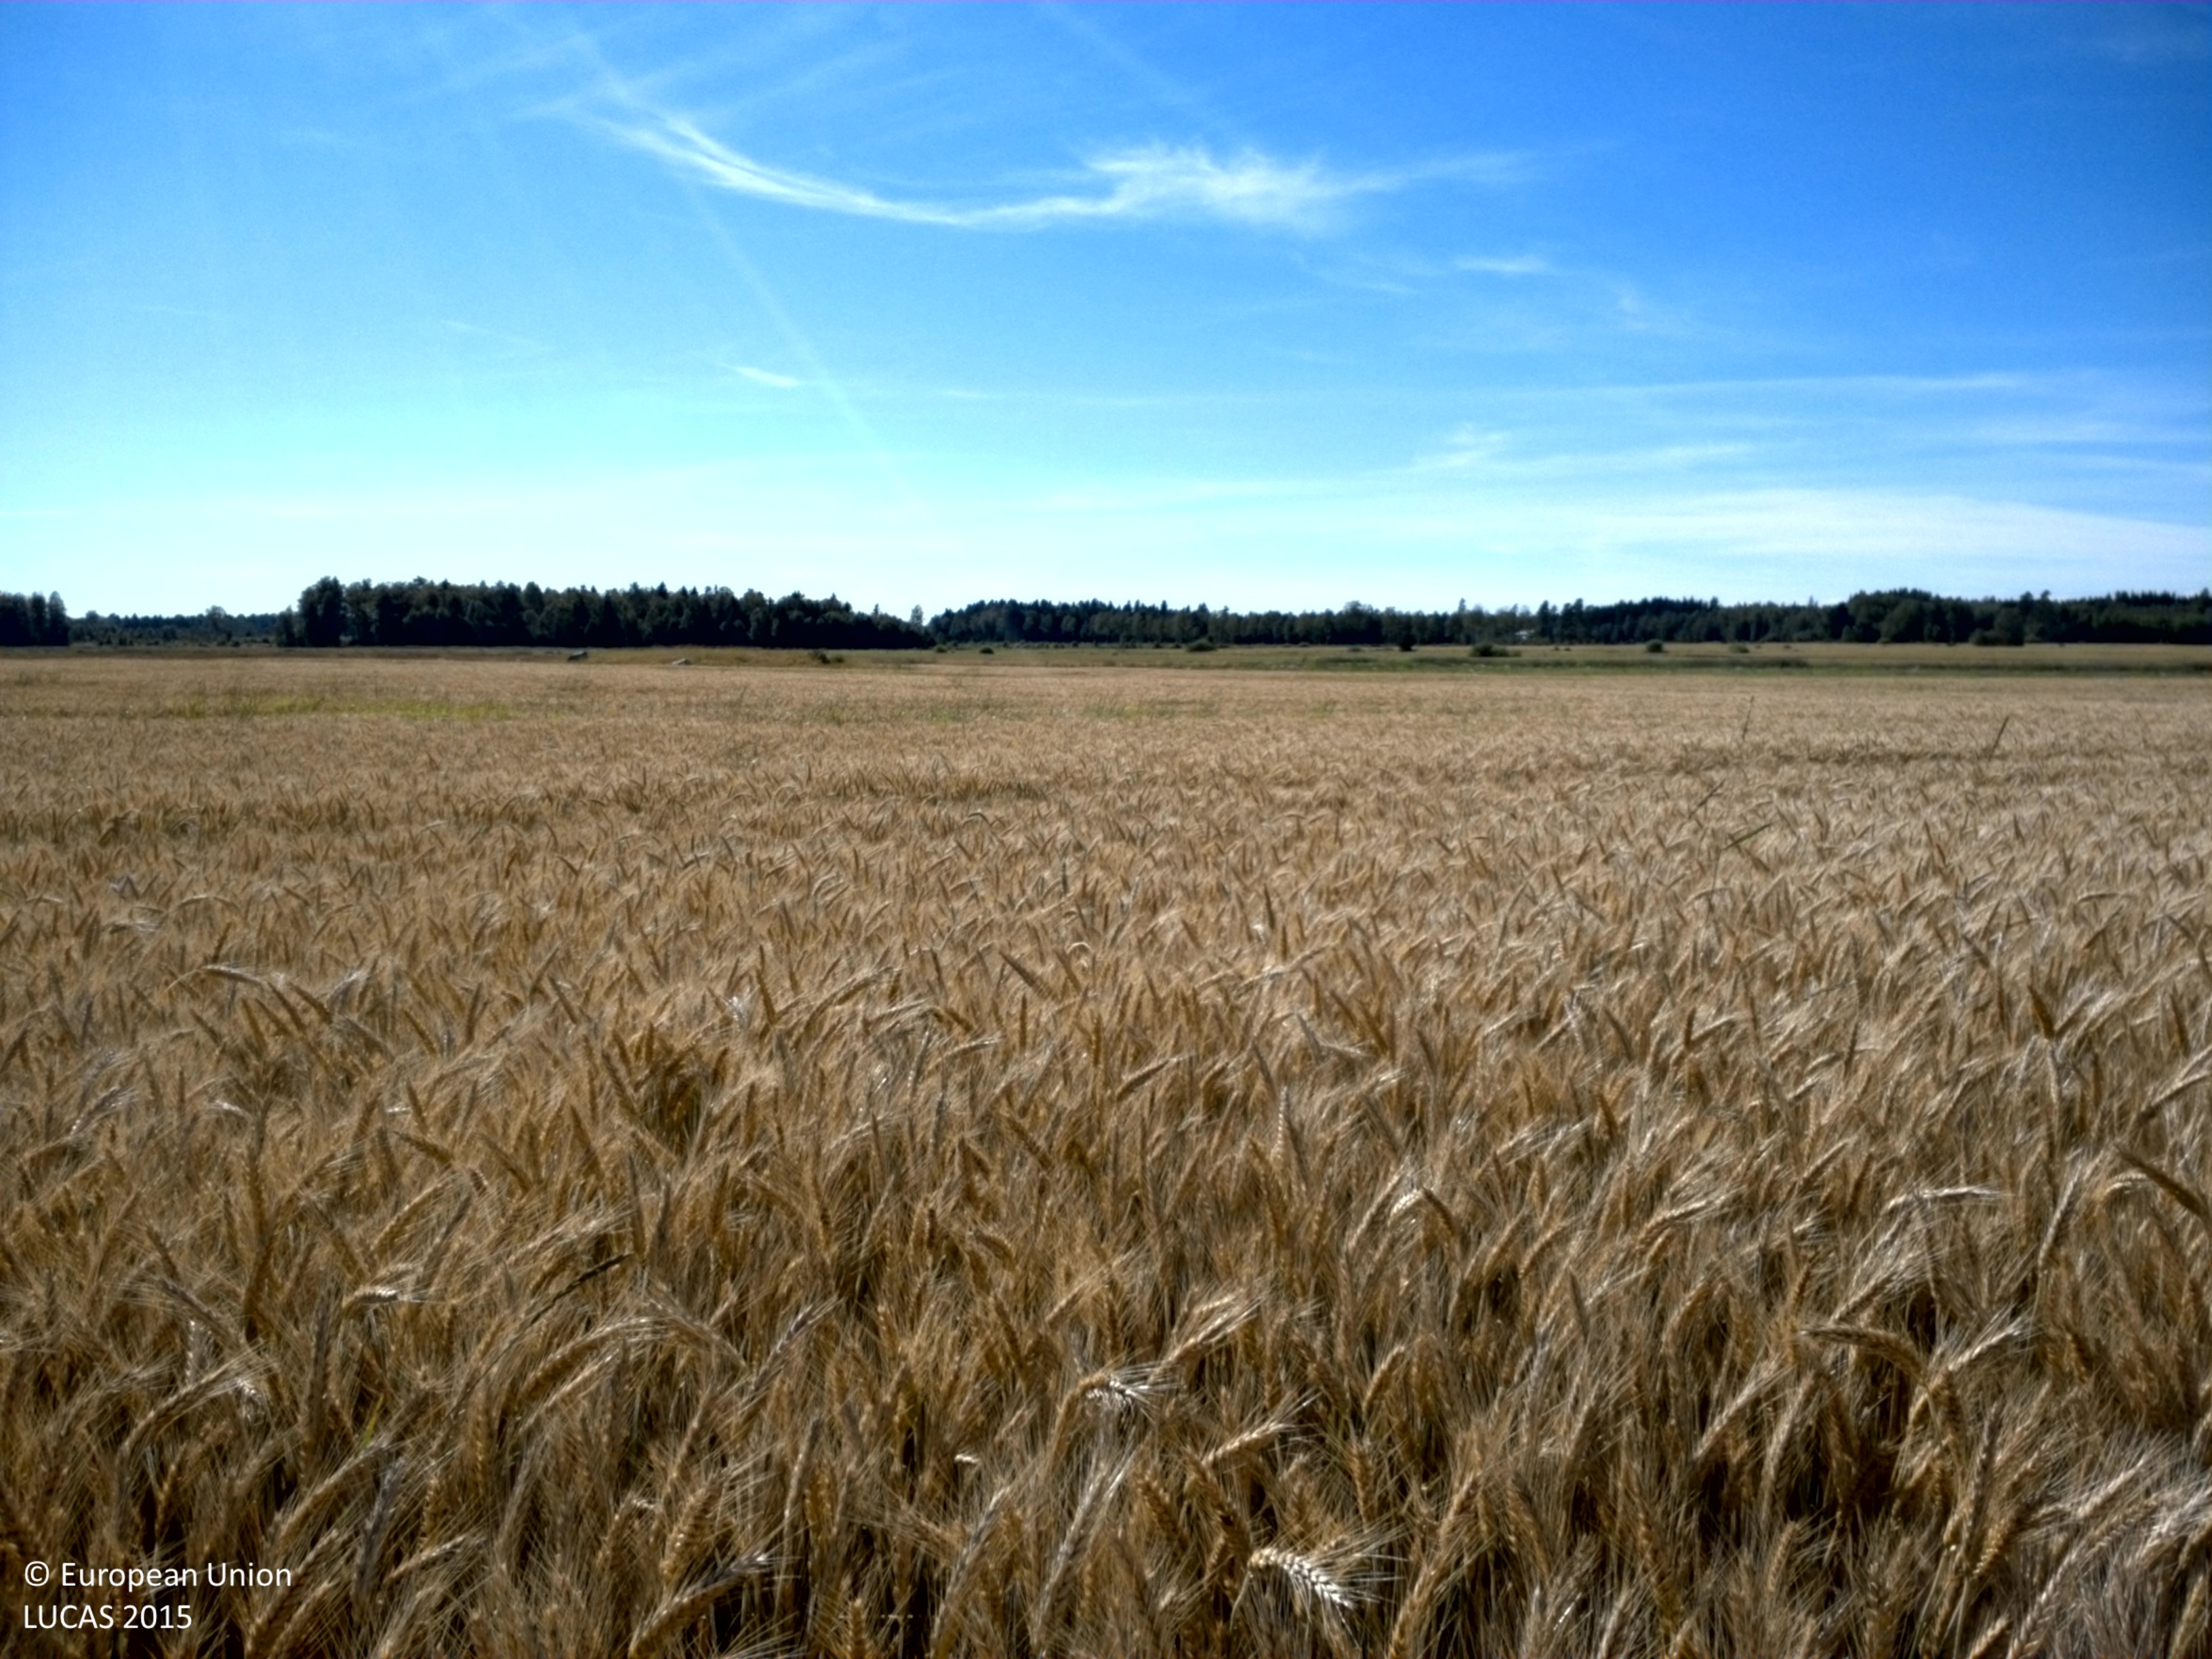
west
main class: Cropland
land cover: Rye
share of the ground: > 75 %
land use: Agriculture (excluding fallow land and kitchen gardens)
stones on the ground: < 10 %
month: August
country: SE
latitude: 60.1677
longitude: 17.0374
